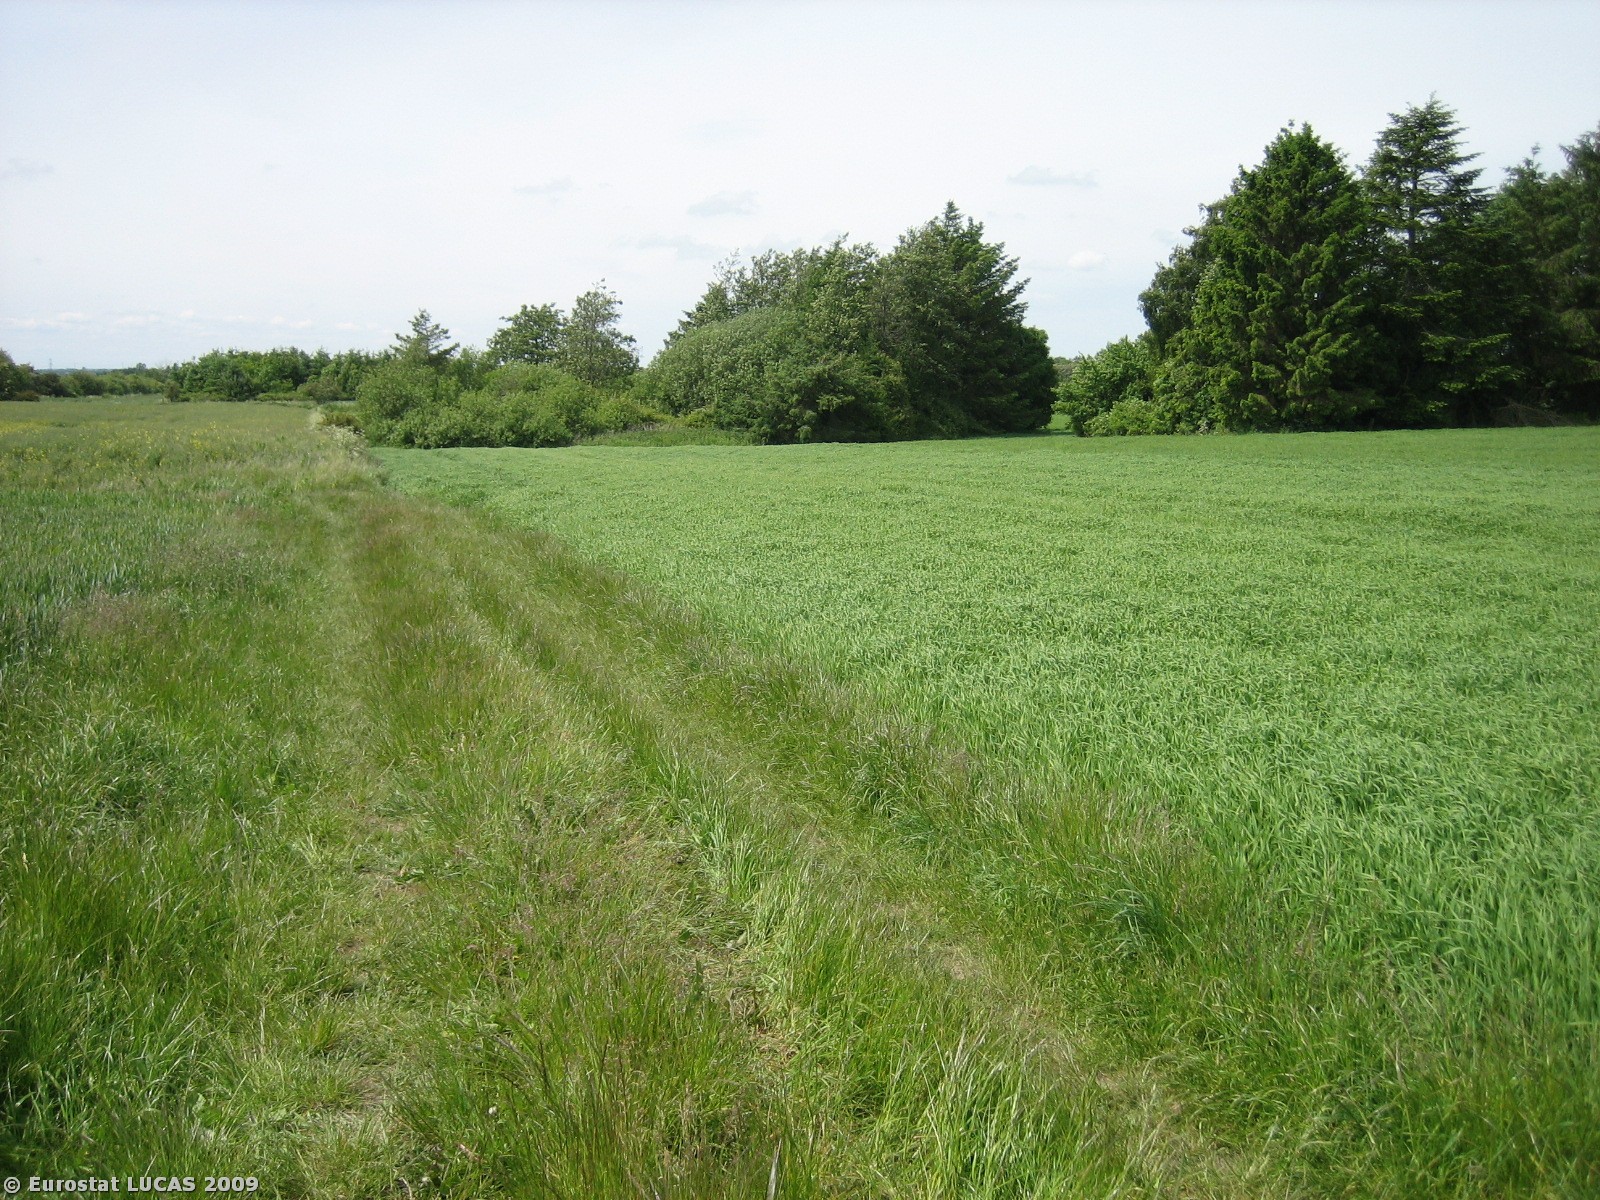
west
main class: Cropland
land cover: Common wheat
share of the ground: > 75 %
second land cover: Barley
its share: < 10 %
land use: Agriculture (excluding fallow land and kitchen gardens)
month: June
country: DK
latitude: 56.2954
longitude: 10.2098
